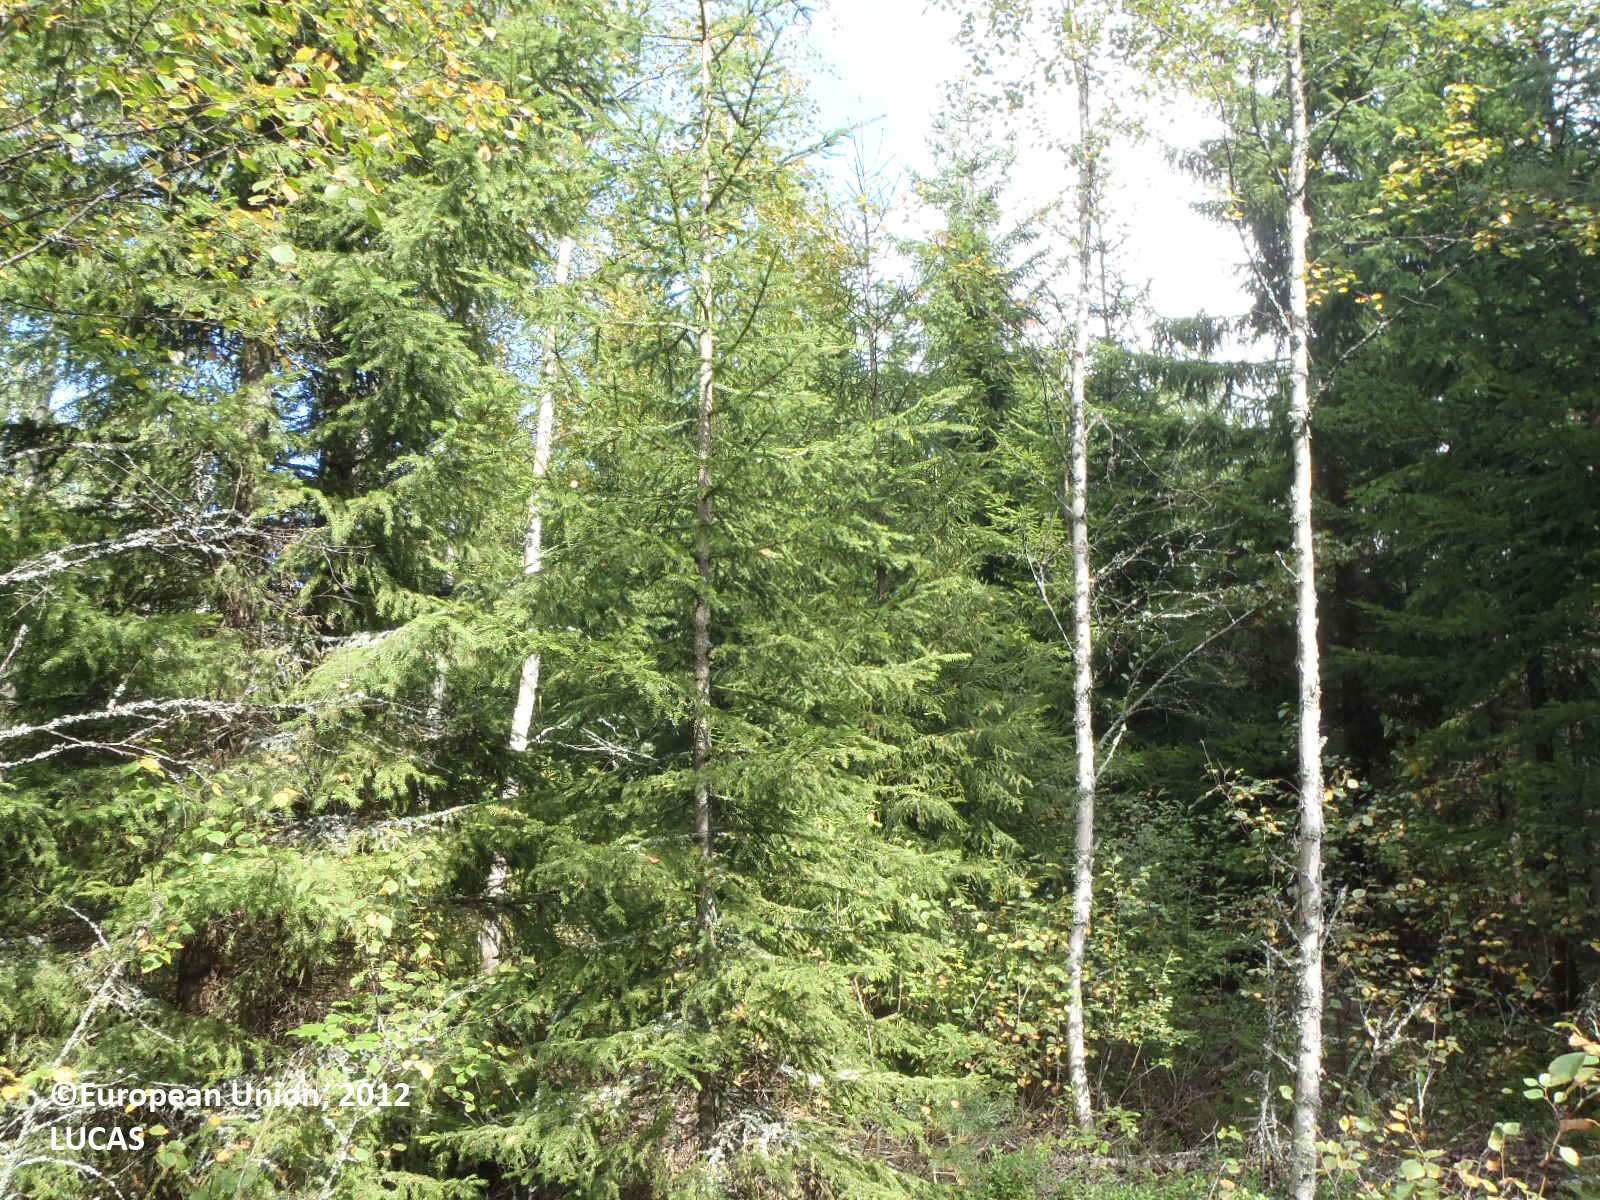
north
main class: Woodland
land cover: Spruce dominated mixed woodland
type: boreal forest
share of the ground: > 75 %
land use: Forestry
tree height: > 5 m
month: August
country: FI
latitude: 60.5316
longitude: 22.3318
